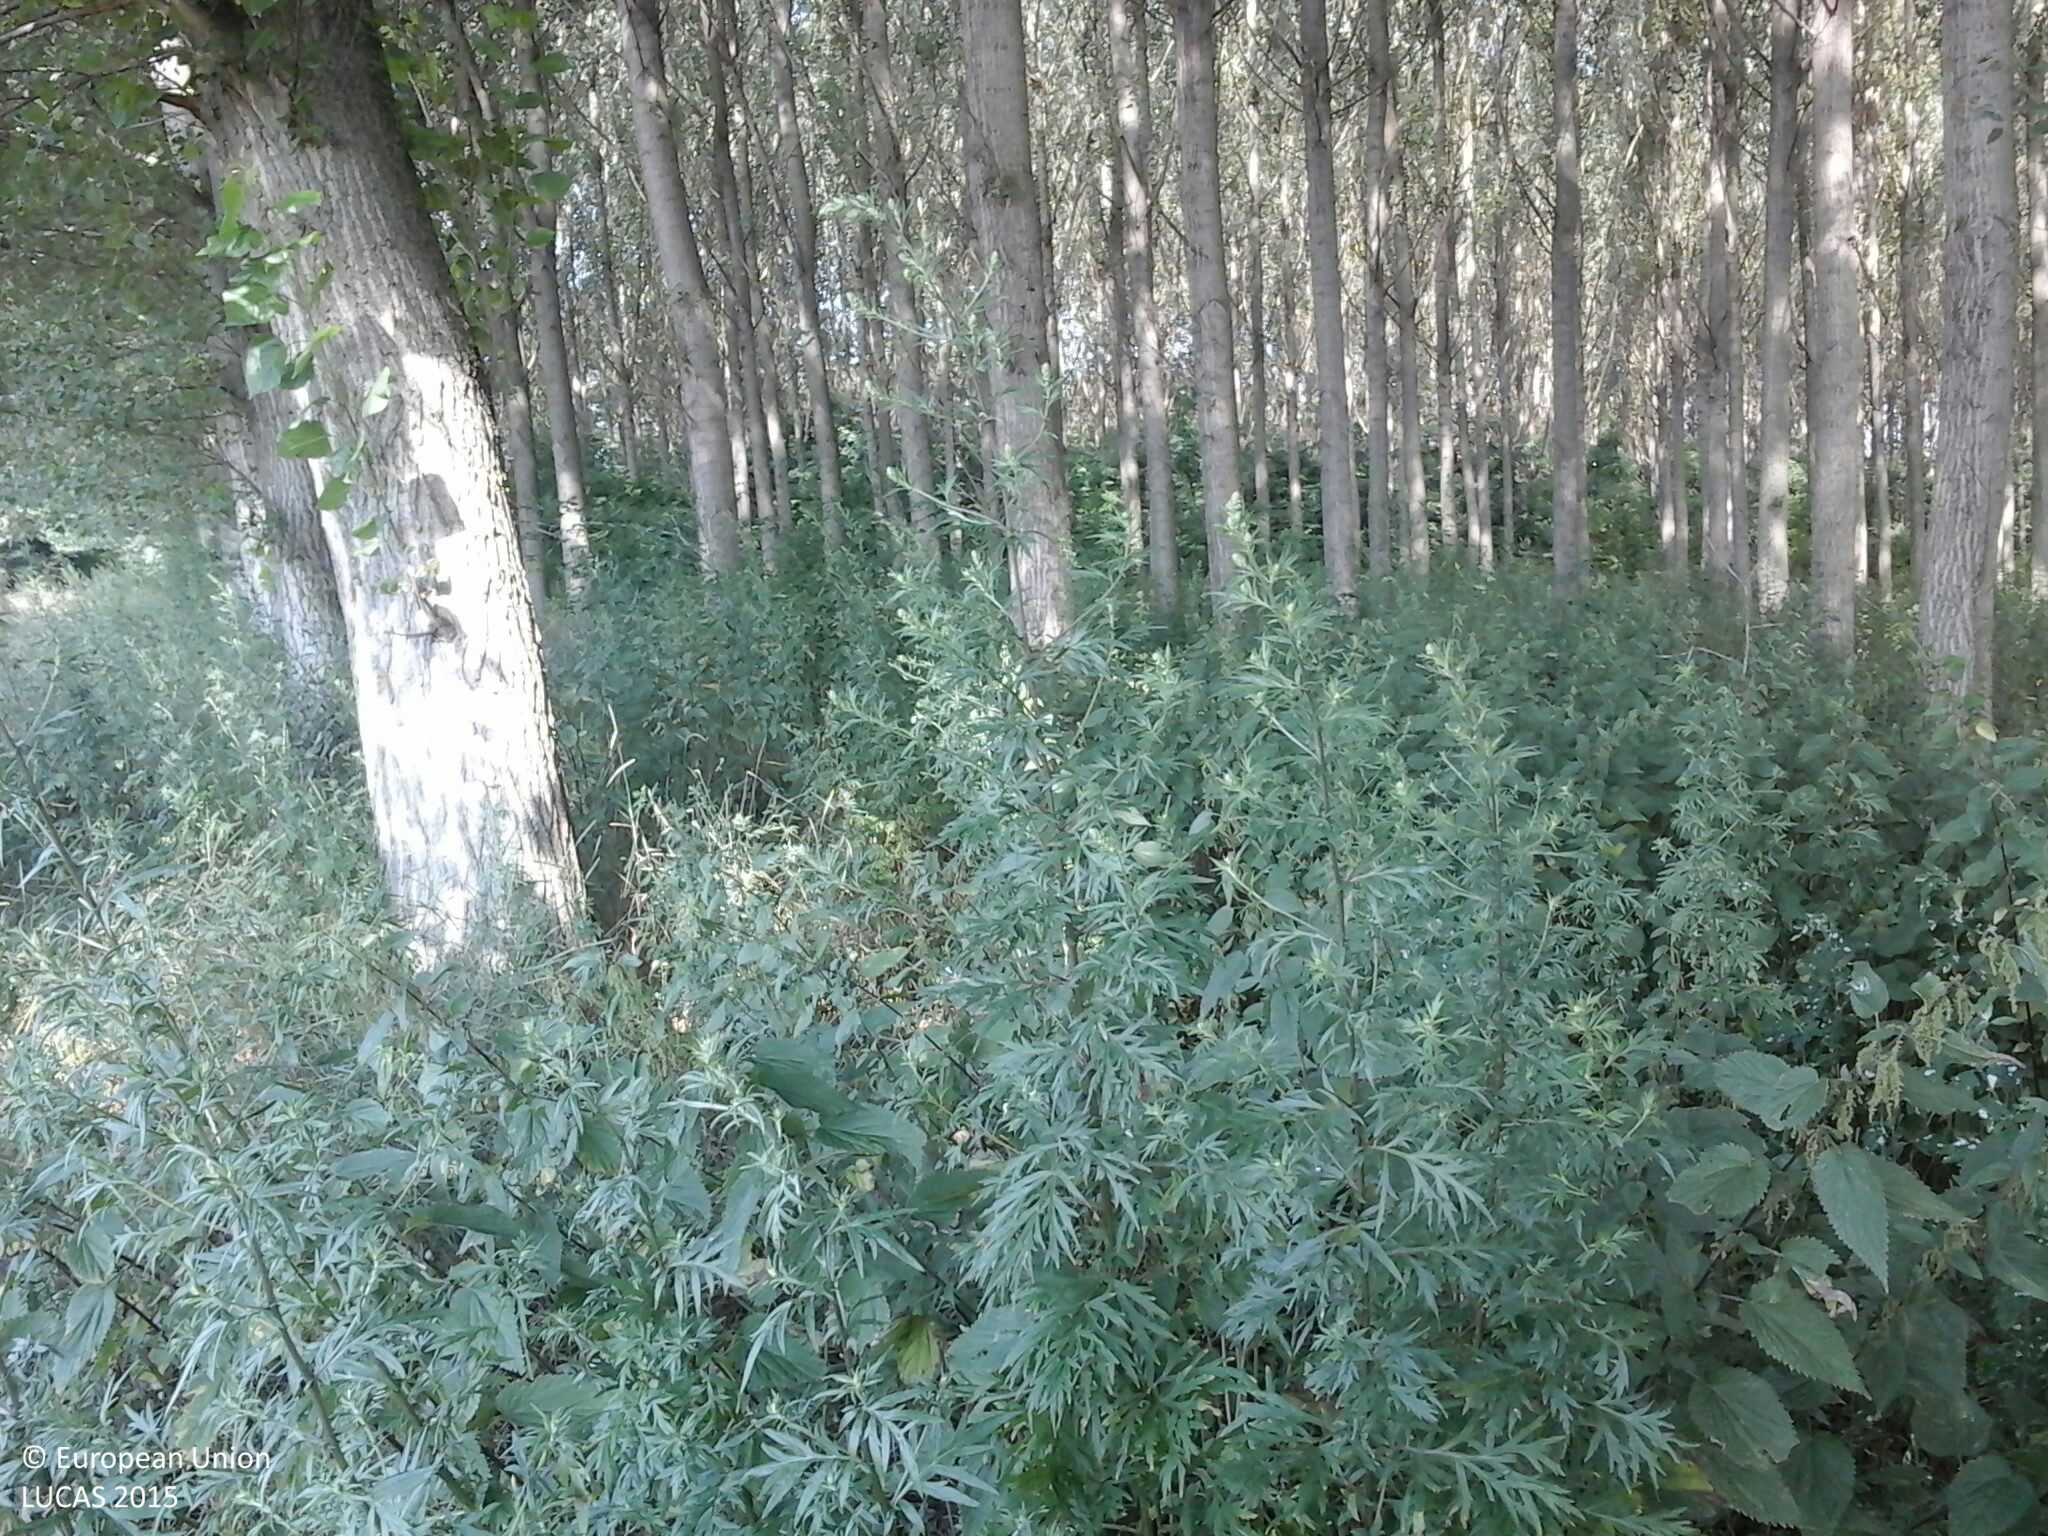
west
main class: Woodland
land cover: Broadleaved woodland
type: mesophytic deciduous forest
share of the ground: > 75 %
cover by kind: broadleaved forest trees 95 %, herbaceous plants 5 %
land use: Forestry
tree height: > 5 m
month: July
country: HU
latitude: 47.7959
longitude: 22.2162
